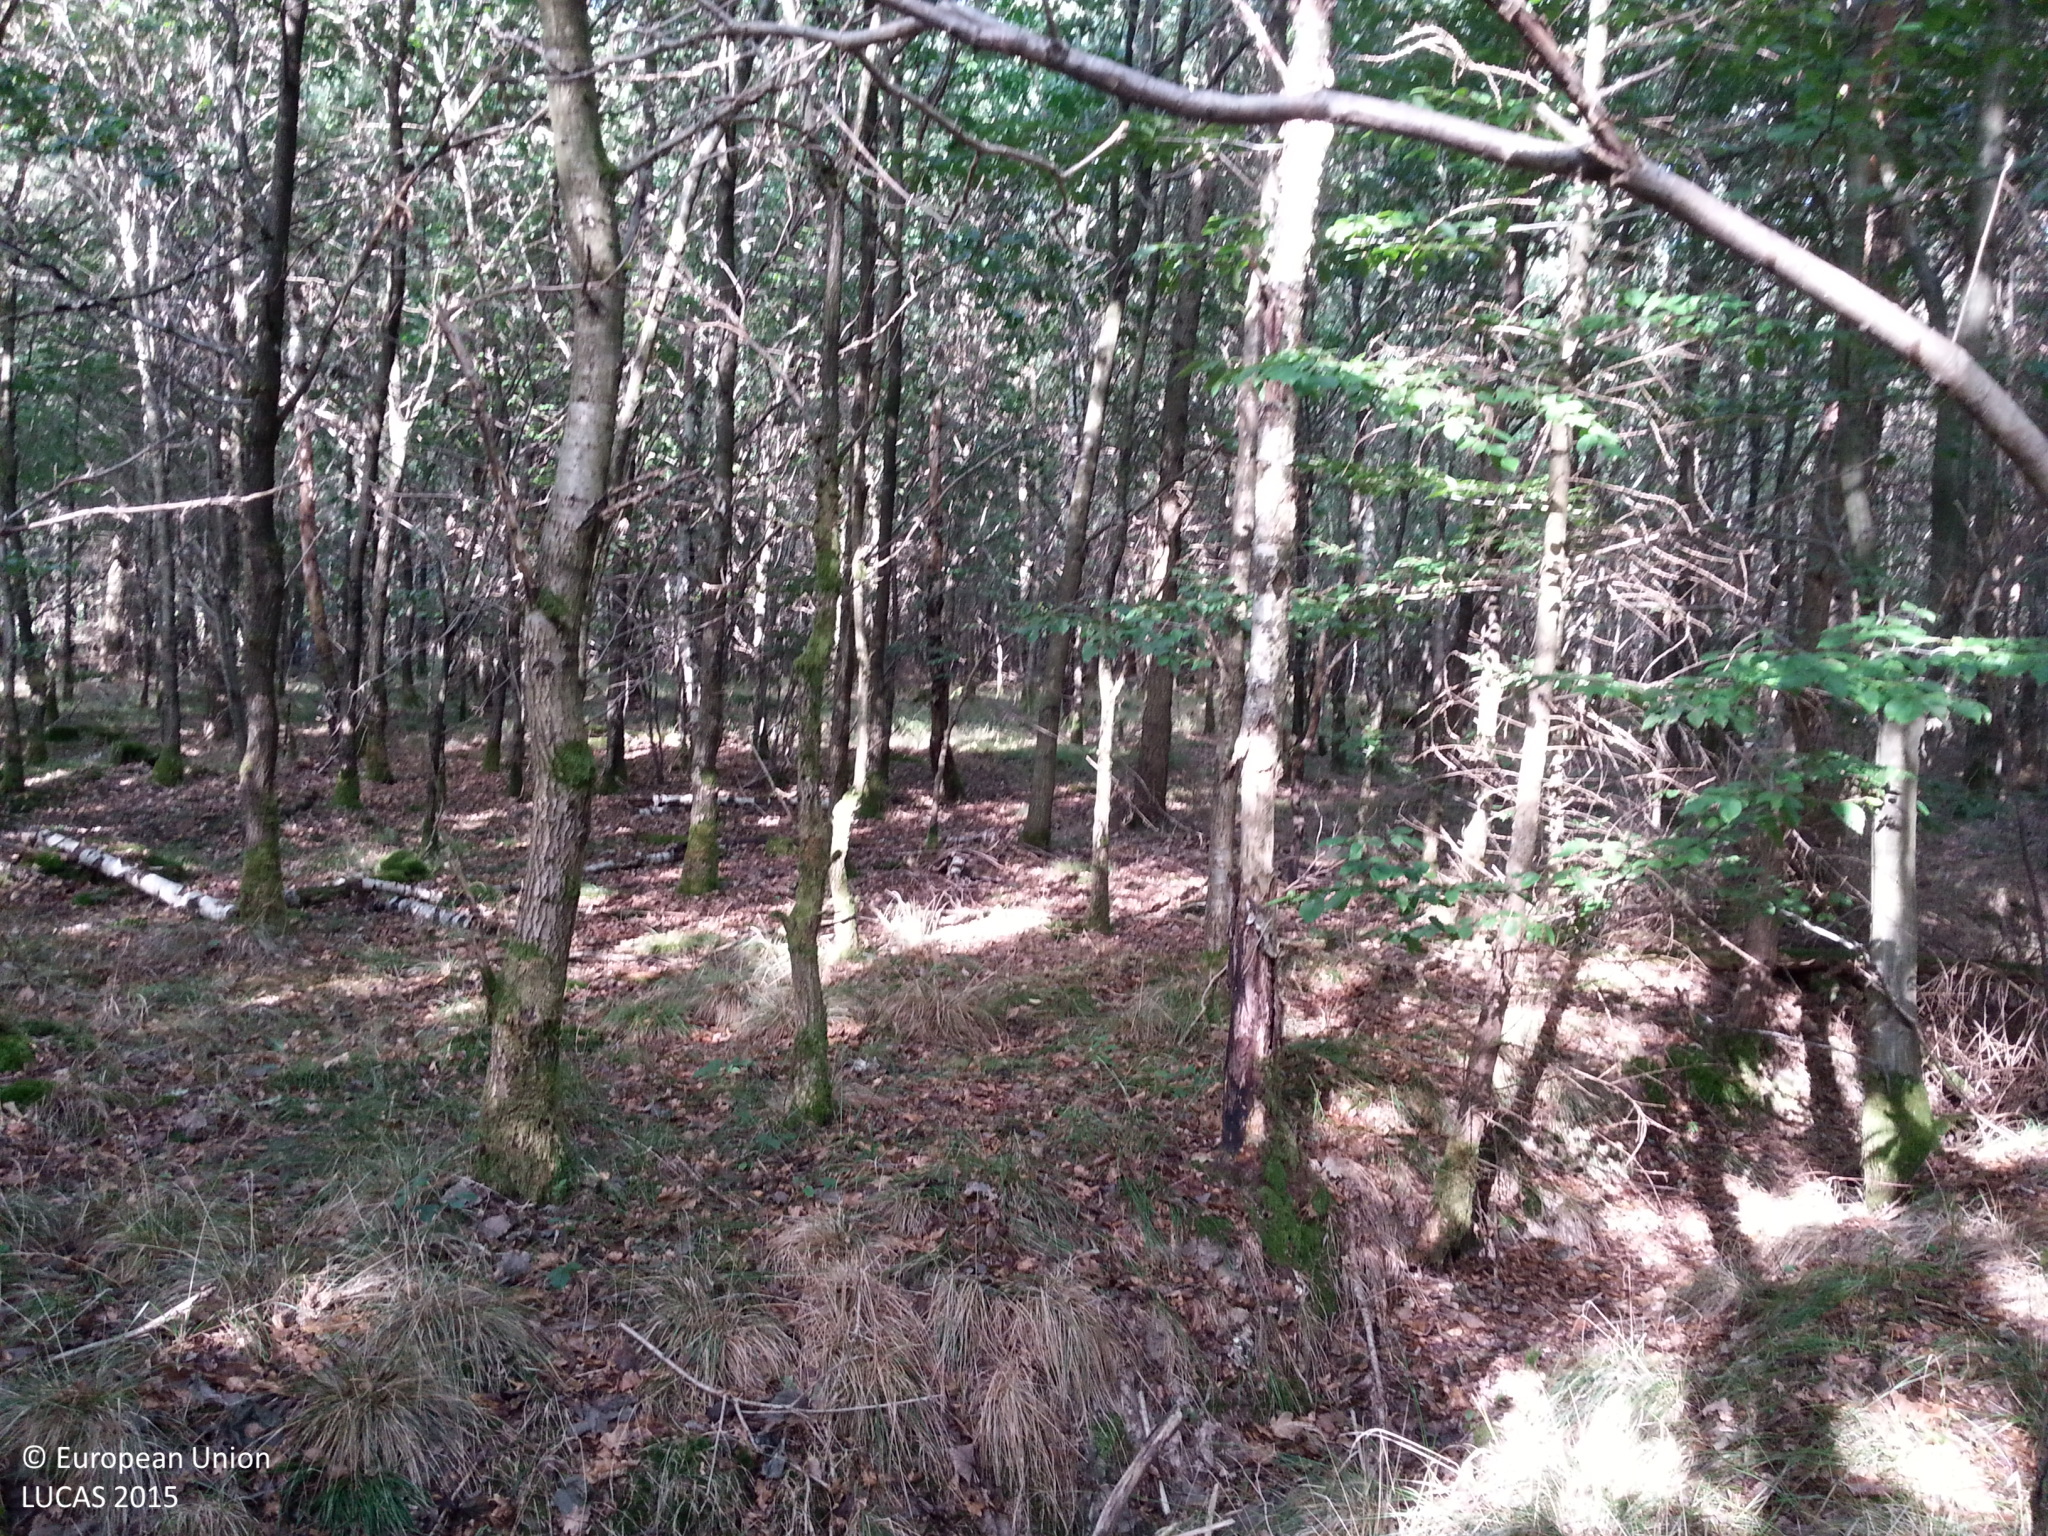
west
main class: Woodland
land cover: Broadleaved woodland
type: mesophytic deciduous forest
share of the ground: > 75 %
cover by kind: broadleaved forest trees 80 %, herbaceous plants 10 %, unconsolidated bare surface 10 %
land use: Forestry
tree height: > 5 m
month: September
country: DE
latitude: 49.6072
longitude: 9.4052
